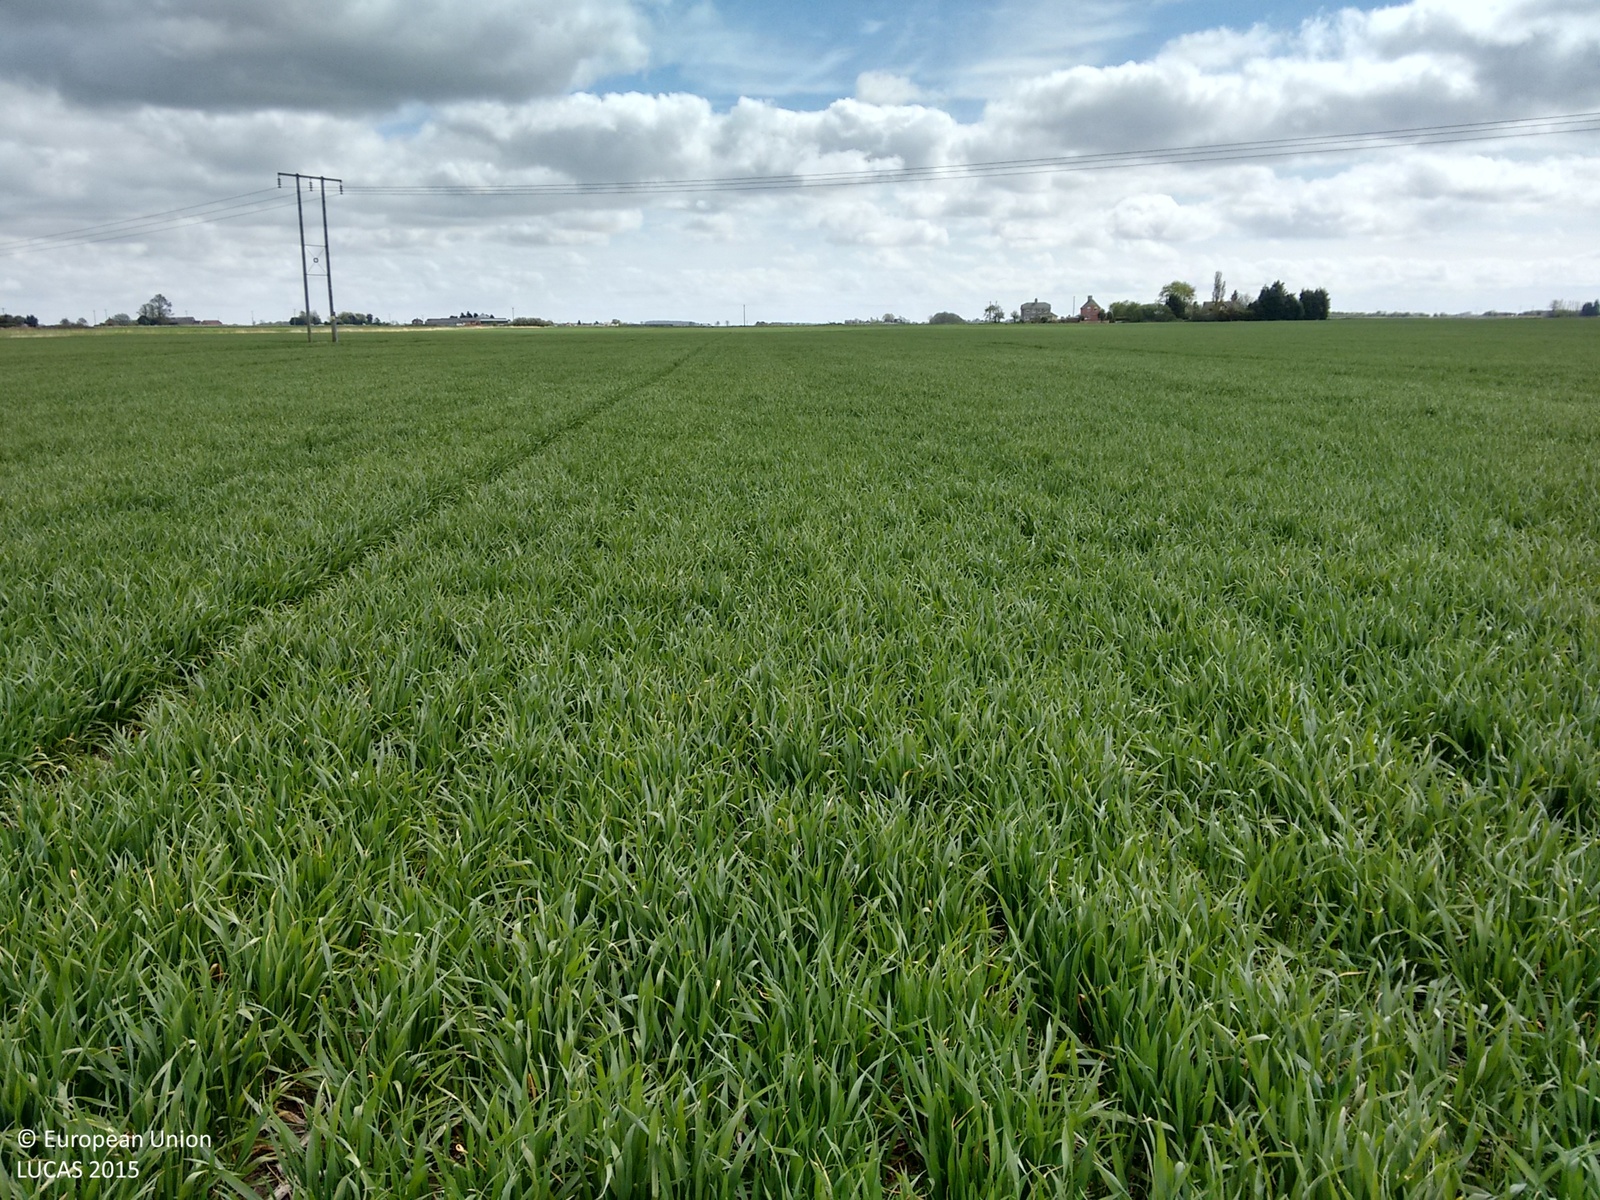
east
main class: Cropland
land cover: Common wheat
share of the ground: > 75 %
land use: Agriculture (excluding fallow land and kitchen gardens)
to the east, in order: Common wheat; Electric lines; Common wheat
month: May
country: GB
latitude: 53.0988
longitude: 0.0367
